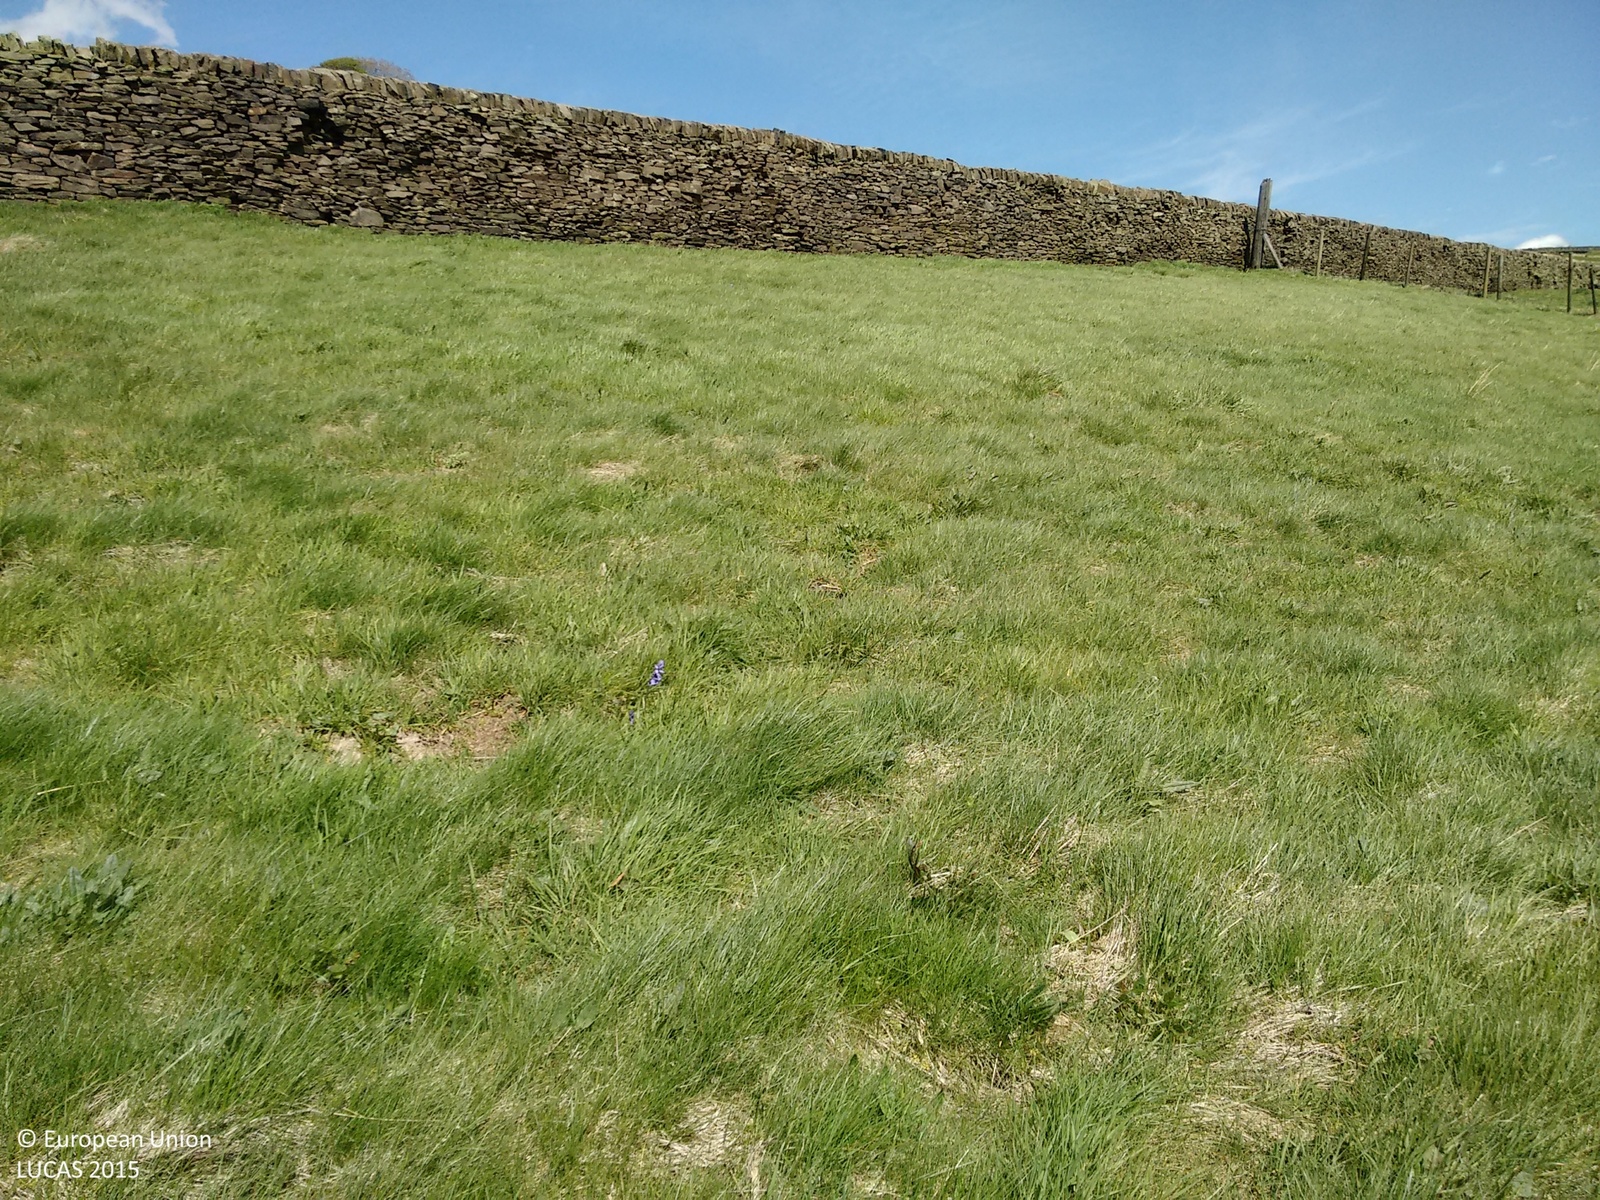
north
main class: Grassland
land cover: Grassland without tree/shrub cover
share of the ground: > 75 %
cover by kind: herbaceous plants 100 %
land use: Agriculture (excluding fallow land and kitchen gardens)
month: May
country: GB
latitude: 53.5634
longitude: -1.8466
